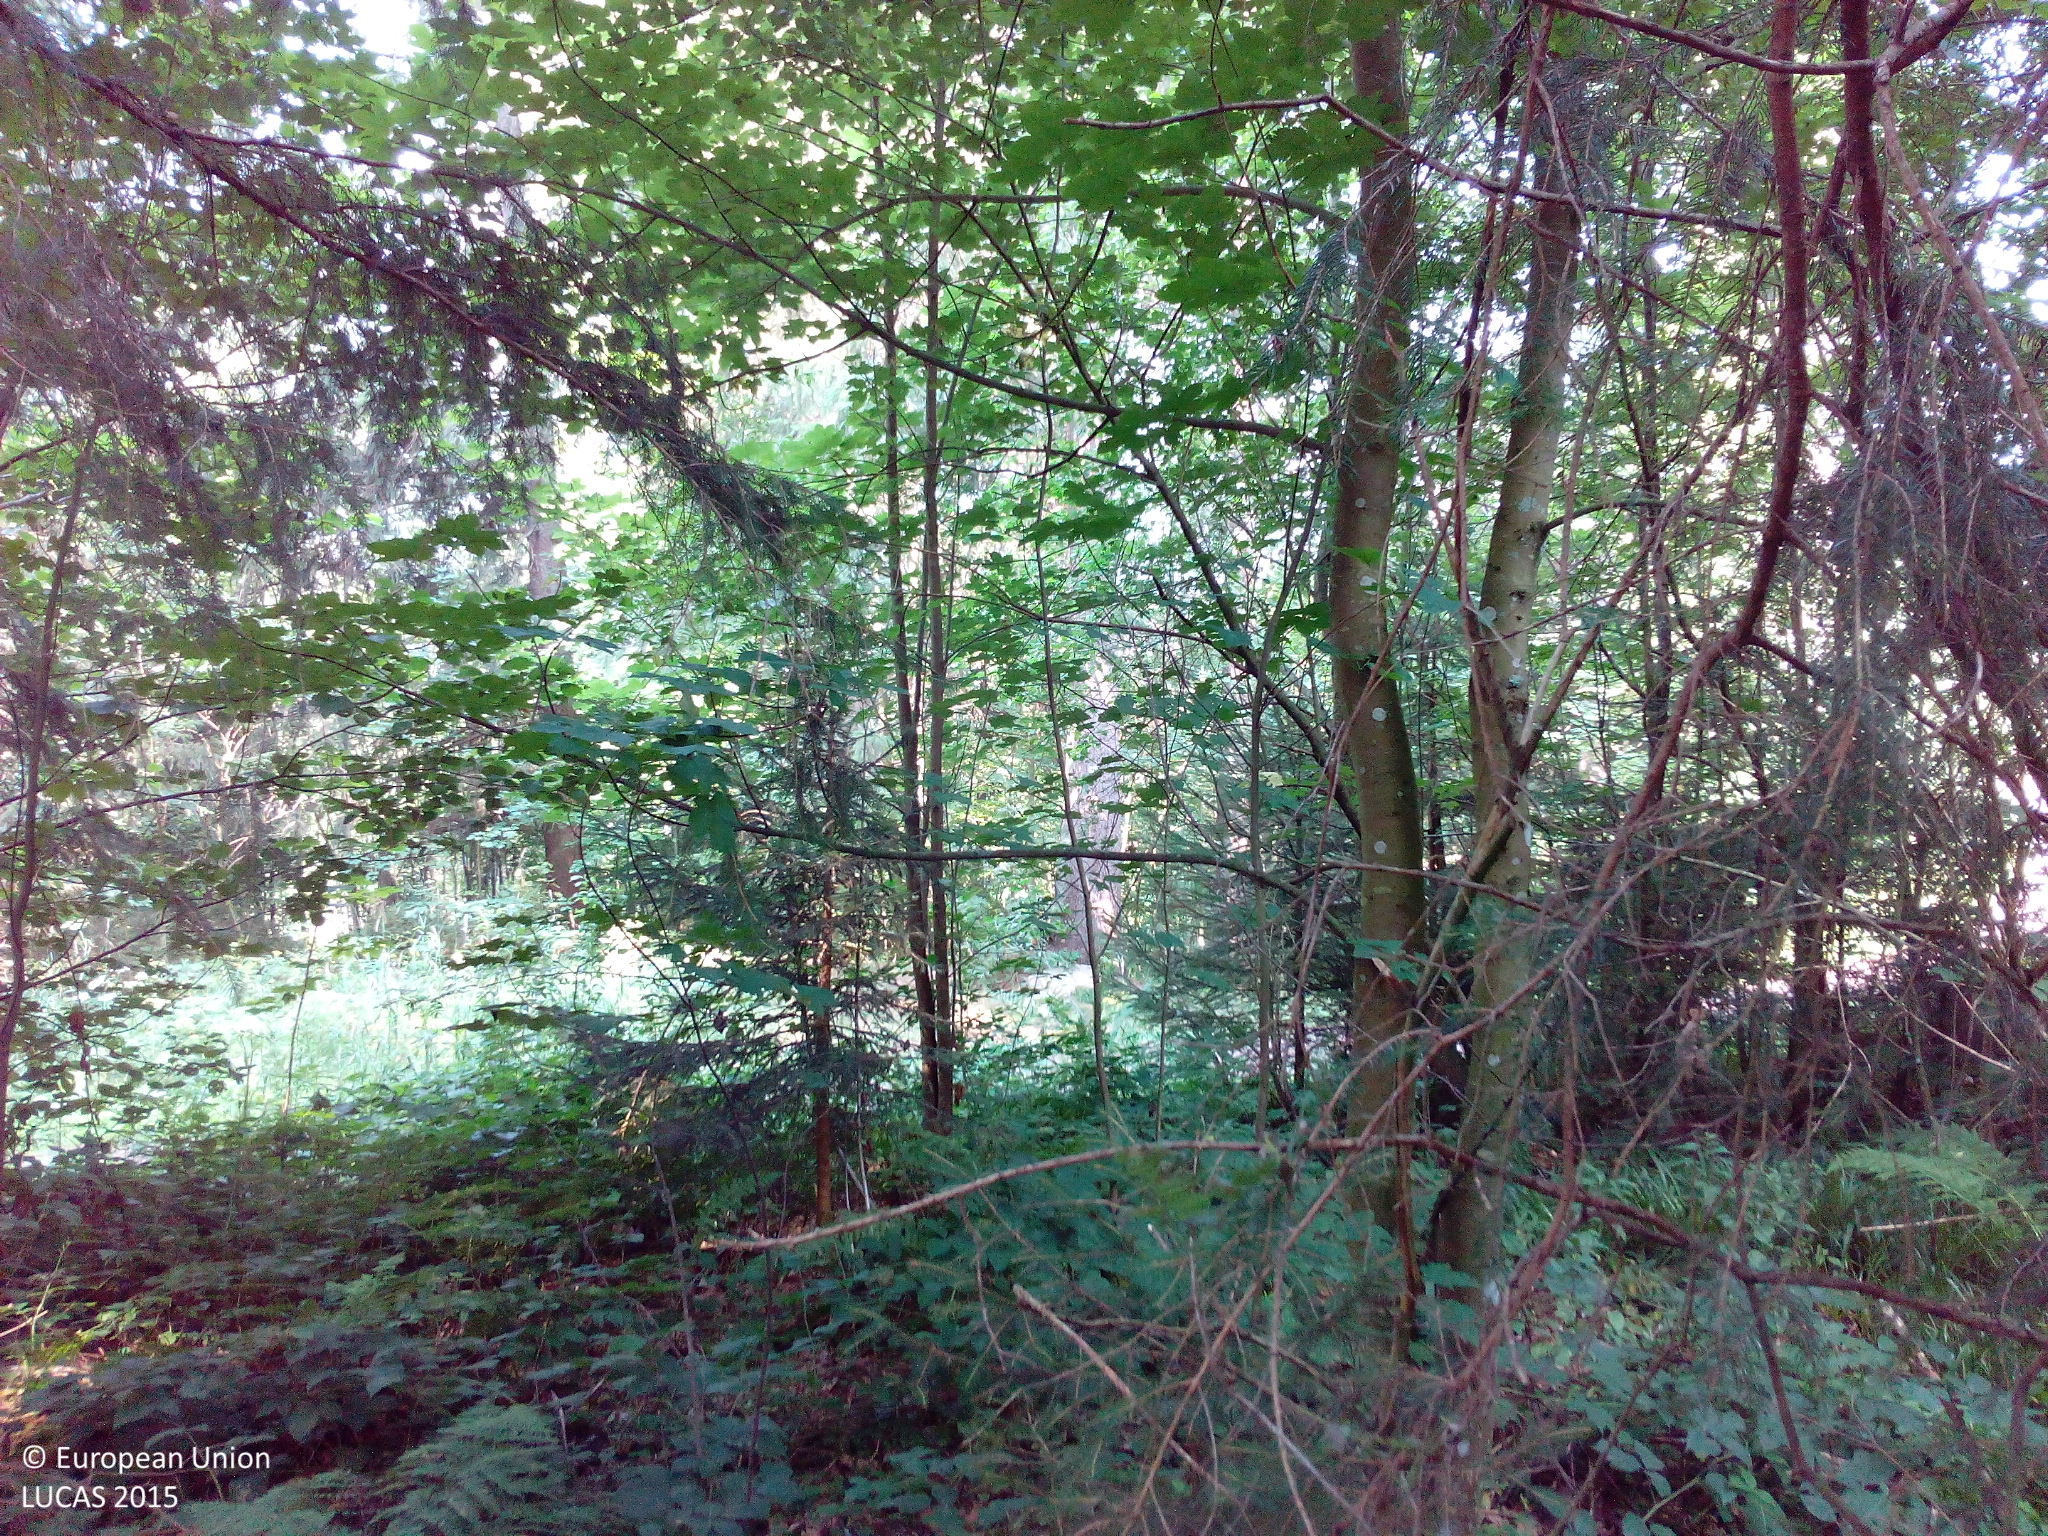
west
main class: Woodland
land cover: Spruce dominated coniferous woodland
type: hemiboreal forest and nemoral coniferous forest and mixed broadleaved-coniferous forest
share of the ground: > 75 %
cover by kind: coniferous forest trees 70 %, broadleaved forest trees 10 %, herbaceous plants 10 %, lichens and mosses 5 %, unconsolidated bare surface 5 %
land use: Forestry
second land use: Amenities, museums, leisure
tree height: > 5 m
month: August
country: DE
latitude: 47.8299
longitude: 8.1443
